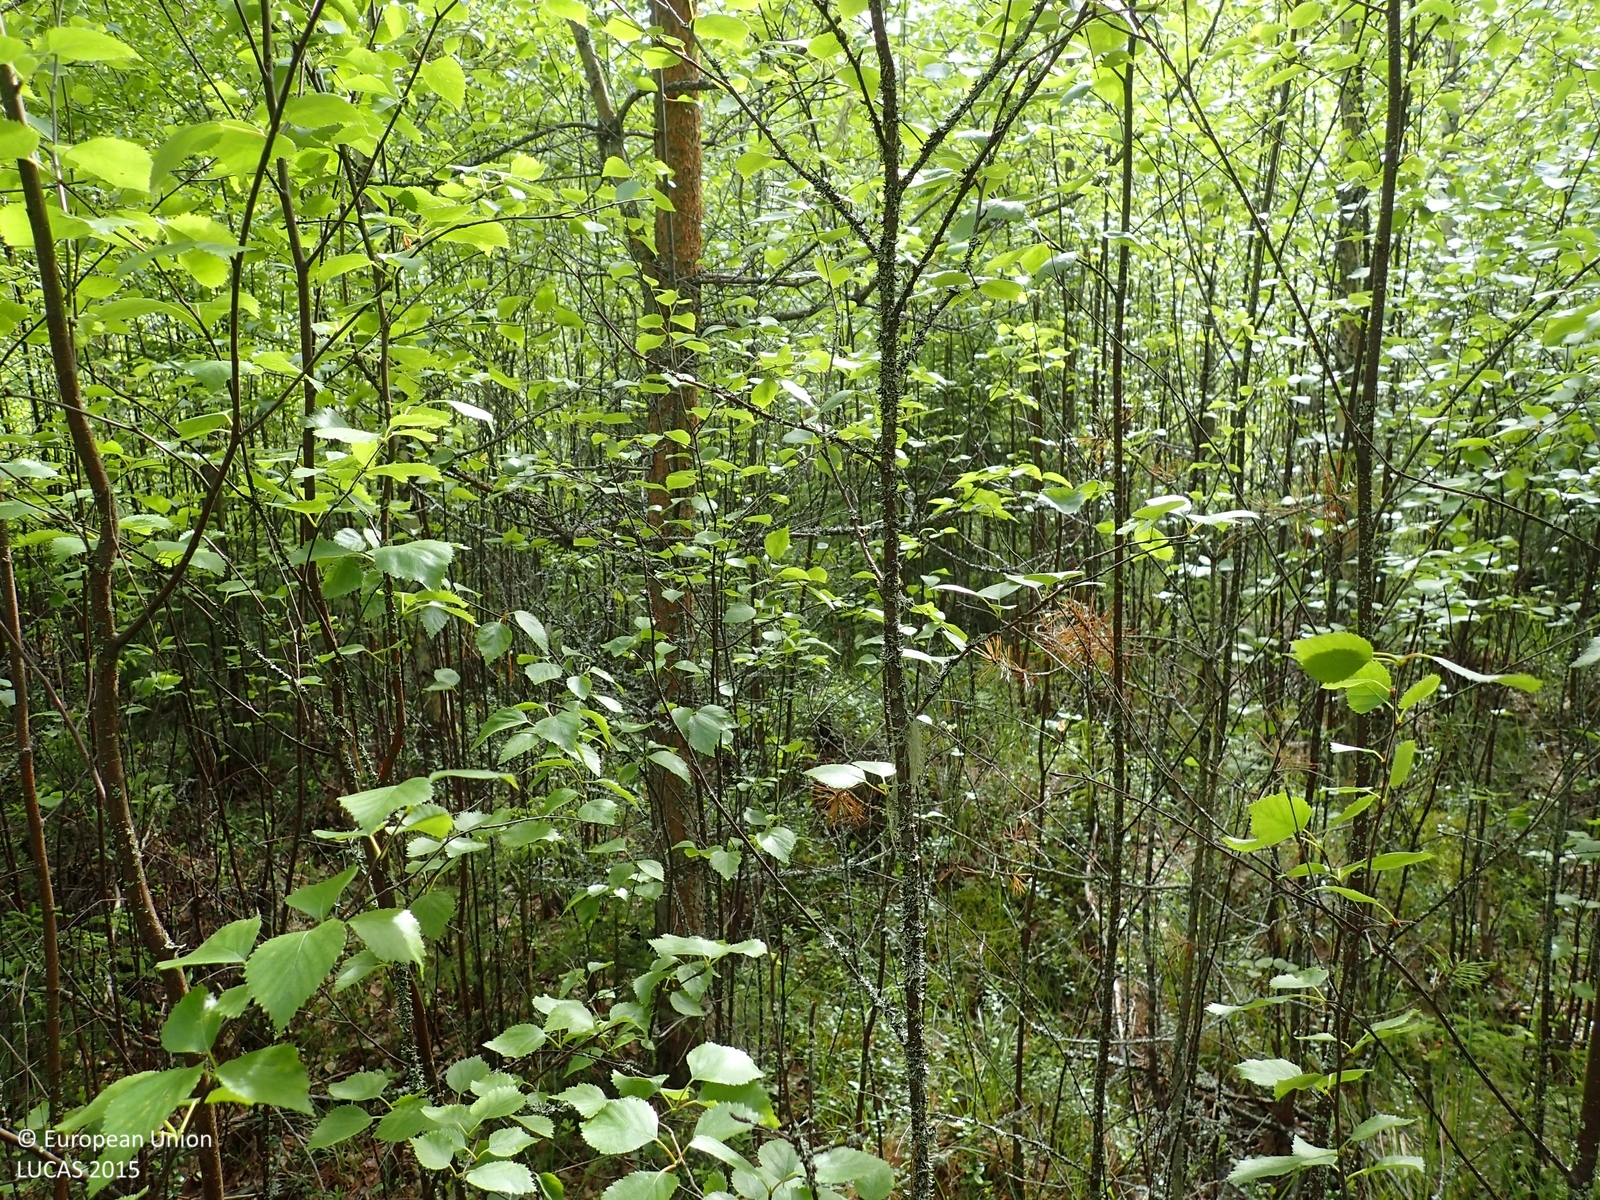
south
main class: Woodland
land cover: Pine dominated mixed woodland
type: boreal forest
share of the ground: > 75 %
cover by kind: coniferous forest trees 50 %, broadleaved forest trees 40 %, shrubs 10 %
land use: Forestry
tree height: < 5 m
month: June
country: FI
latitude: 62.4445
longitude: 21.4953
